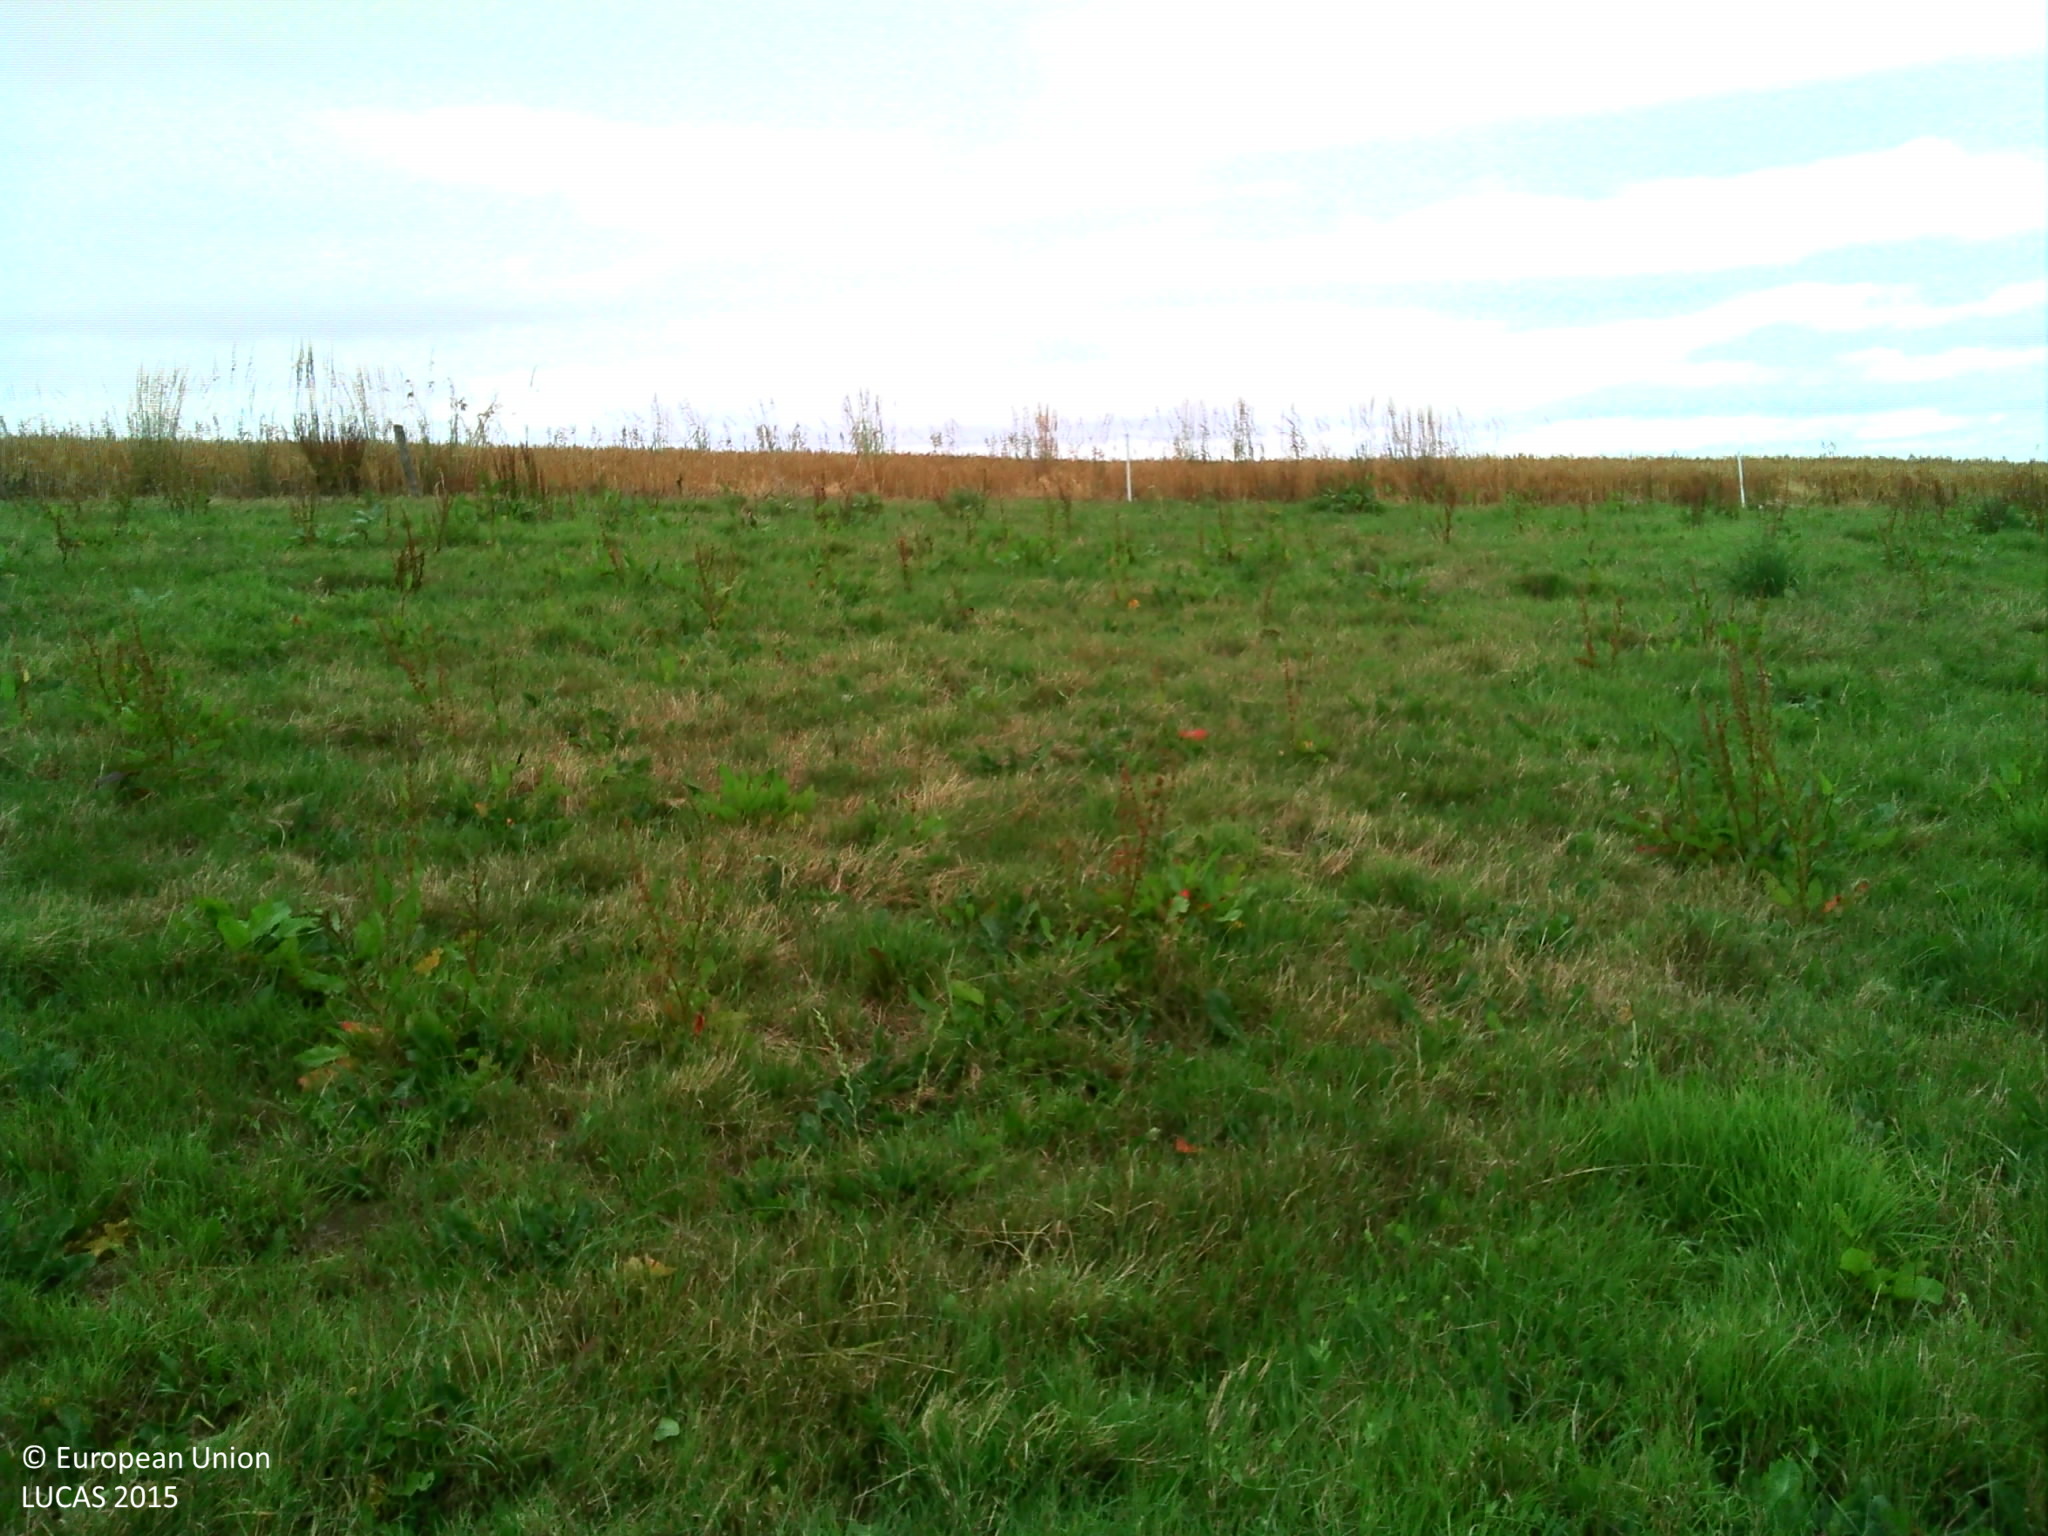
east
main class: Grassland
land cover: Grassland without tree/shrub cover
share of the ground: > 75 %
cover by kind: herbaceous plants 100 %
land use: Agriculture (excluding fallow land and kitchen gardens)
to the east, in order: Grassland without tree/shrub cover; Fences; Barley; Maize
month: July
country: FR
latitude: 48.0987
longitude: -3.6559
